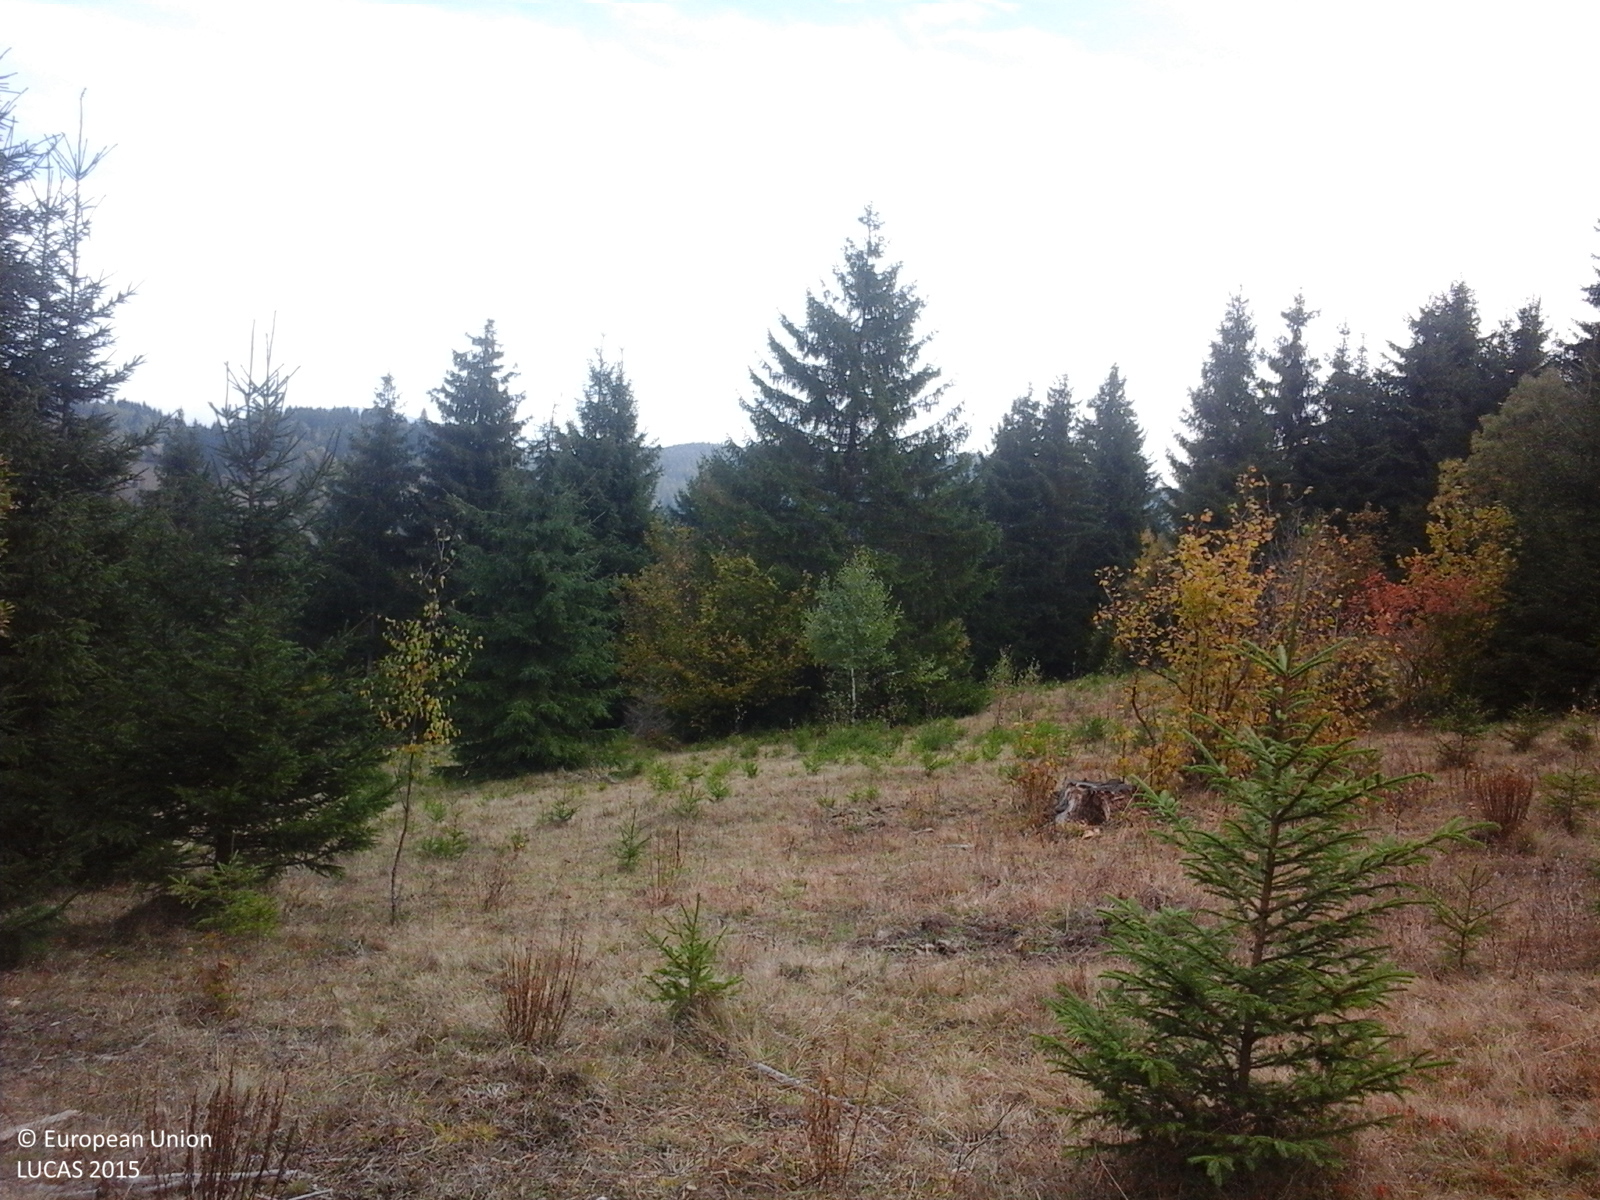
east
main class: Grassland
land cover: Grassland with sparse tree/shrub cover
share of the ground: > 75 %
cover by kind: herbaceous plants 85 %, shrubs 10 %, coniferous forest trees 5 %
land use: Forestry
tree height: < 5 m
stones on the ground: < 10 %
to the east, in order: Grassland with sparse tree/shrub cover; Spruce dominated mixed woodland; Grassland with sparse tree/shrub cover; Spruce dominated mixed woodland
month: October
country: RO
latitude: 46.2896
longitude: 26.0208
